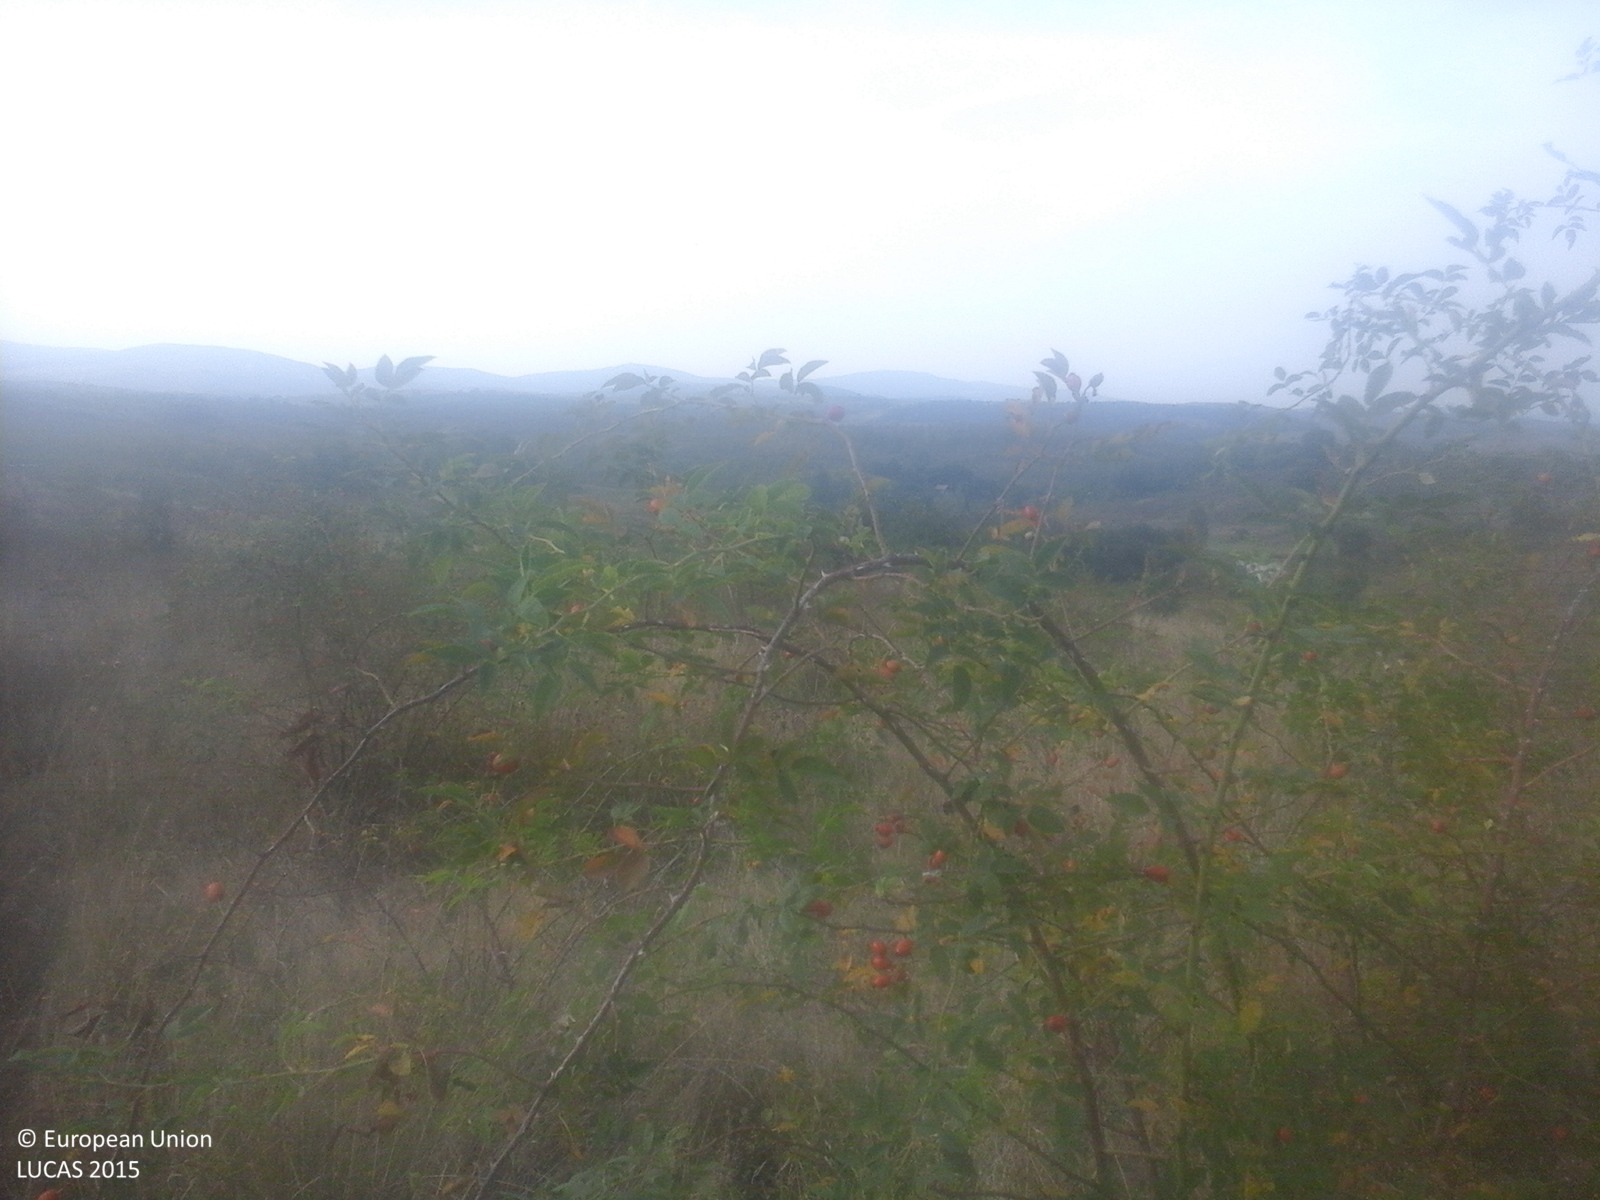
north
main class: Shrubland
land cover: Shrubland without tree cover
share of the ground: > 75 %
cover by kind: shrubs 60 %, herbaceous plants 40 %
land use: Agriculture (excluding fallow land and kitchen gardens)
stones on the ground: < 10 %
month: September
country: RO
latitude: 47.0328
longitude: 23.1317
